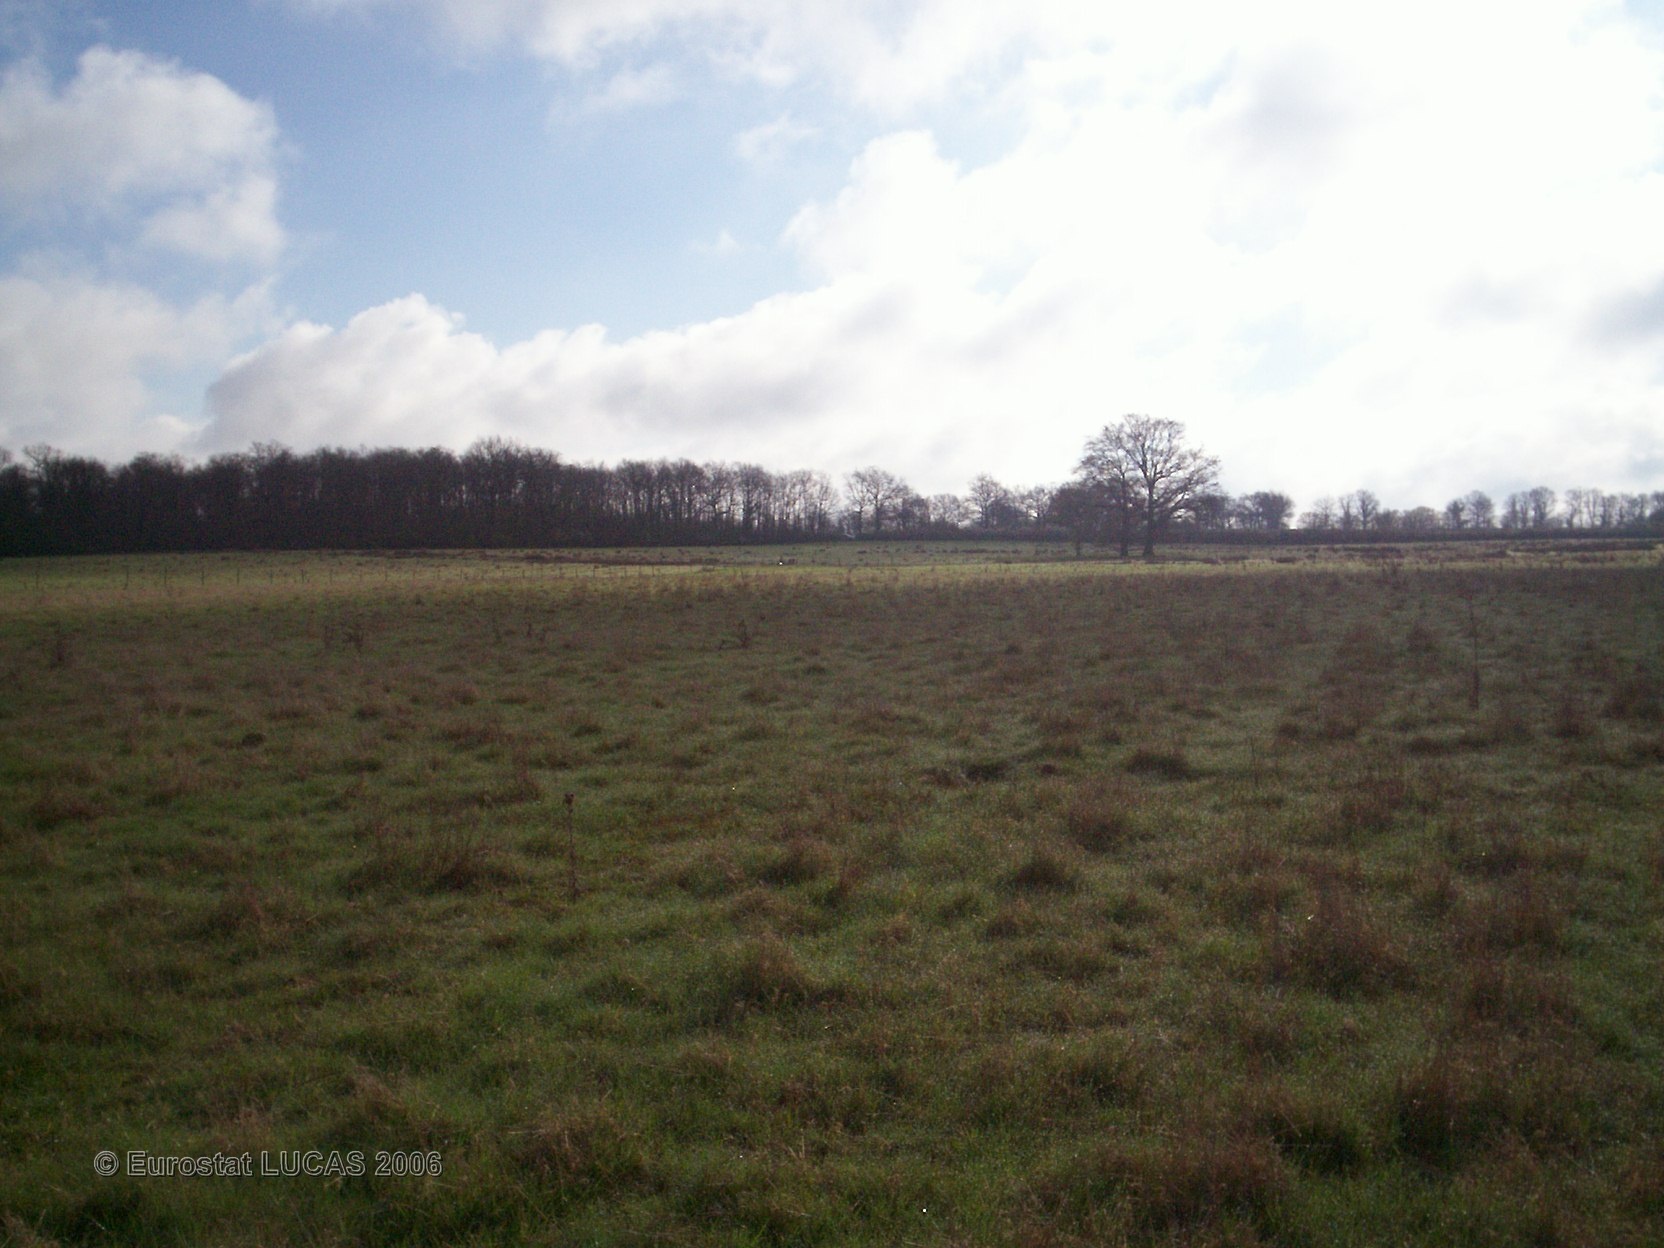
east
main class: Grassland
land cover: Grassland without tree/shrub cover
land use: Agriculture (excluding fallow land and kitchen gardens)
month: April
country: FR
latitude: 46.4237
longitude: 0.9953
